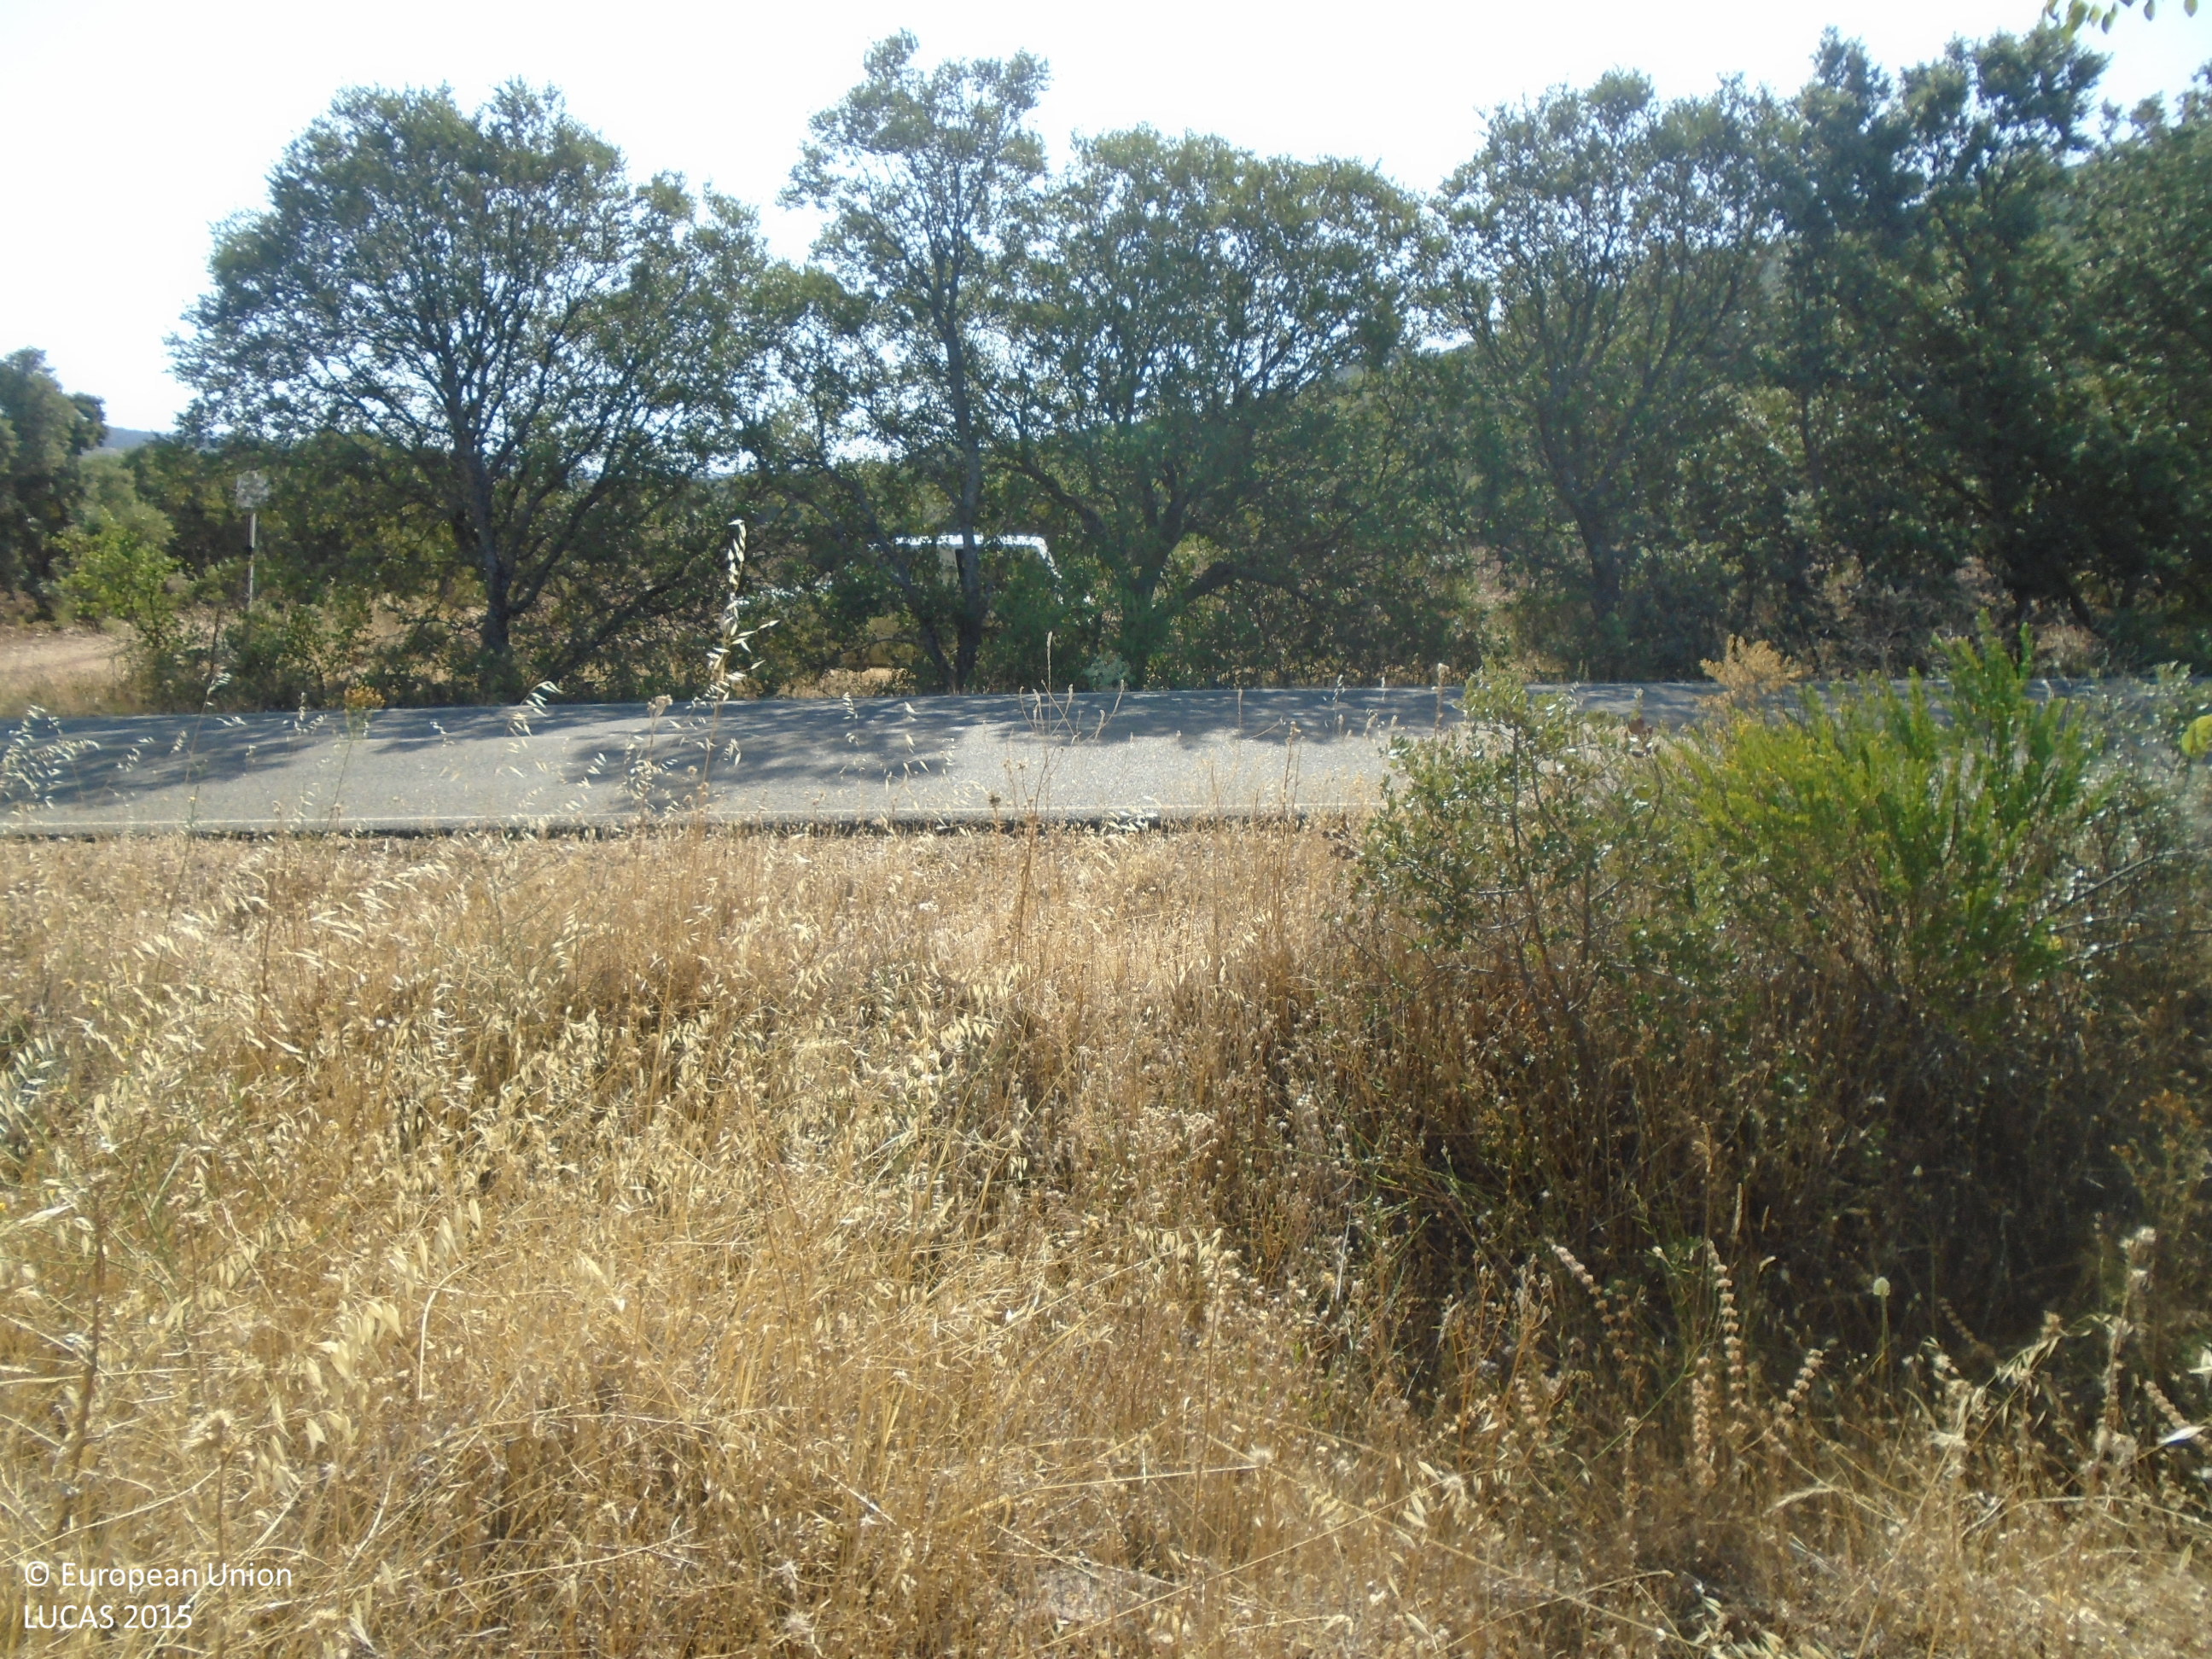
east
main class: Woodland
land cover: Broadleaved woodland
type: broadleaved evergreen forest
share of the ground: > 75 %
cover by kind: broadleaved forest trees 90 %, shrubs 10 %
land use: Semi-natural and natural areas not in use
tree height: > 5 m
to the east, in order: Broadleaved woodland; Tracks; Other bare soil
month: July
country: ES
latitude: 39.3021
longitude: -3.6941
